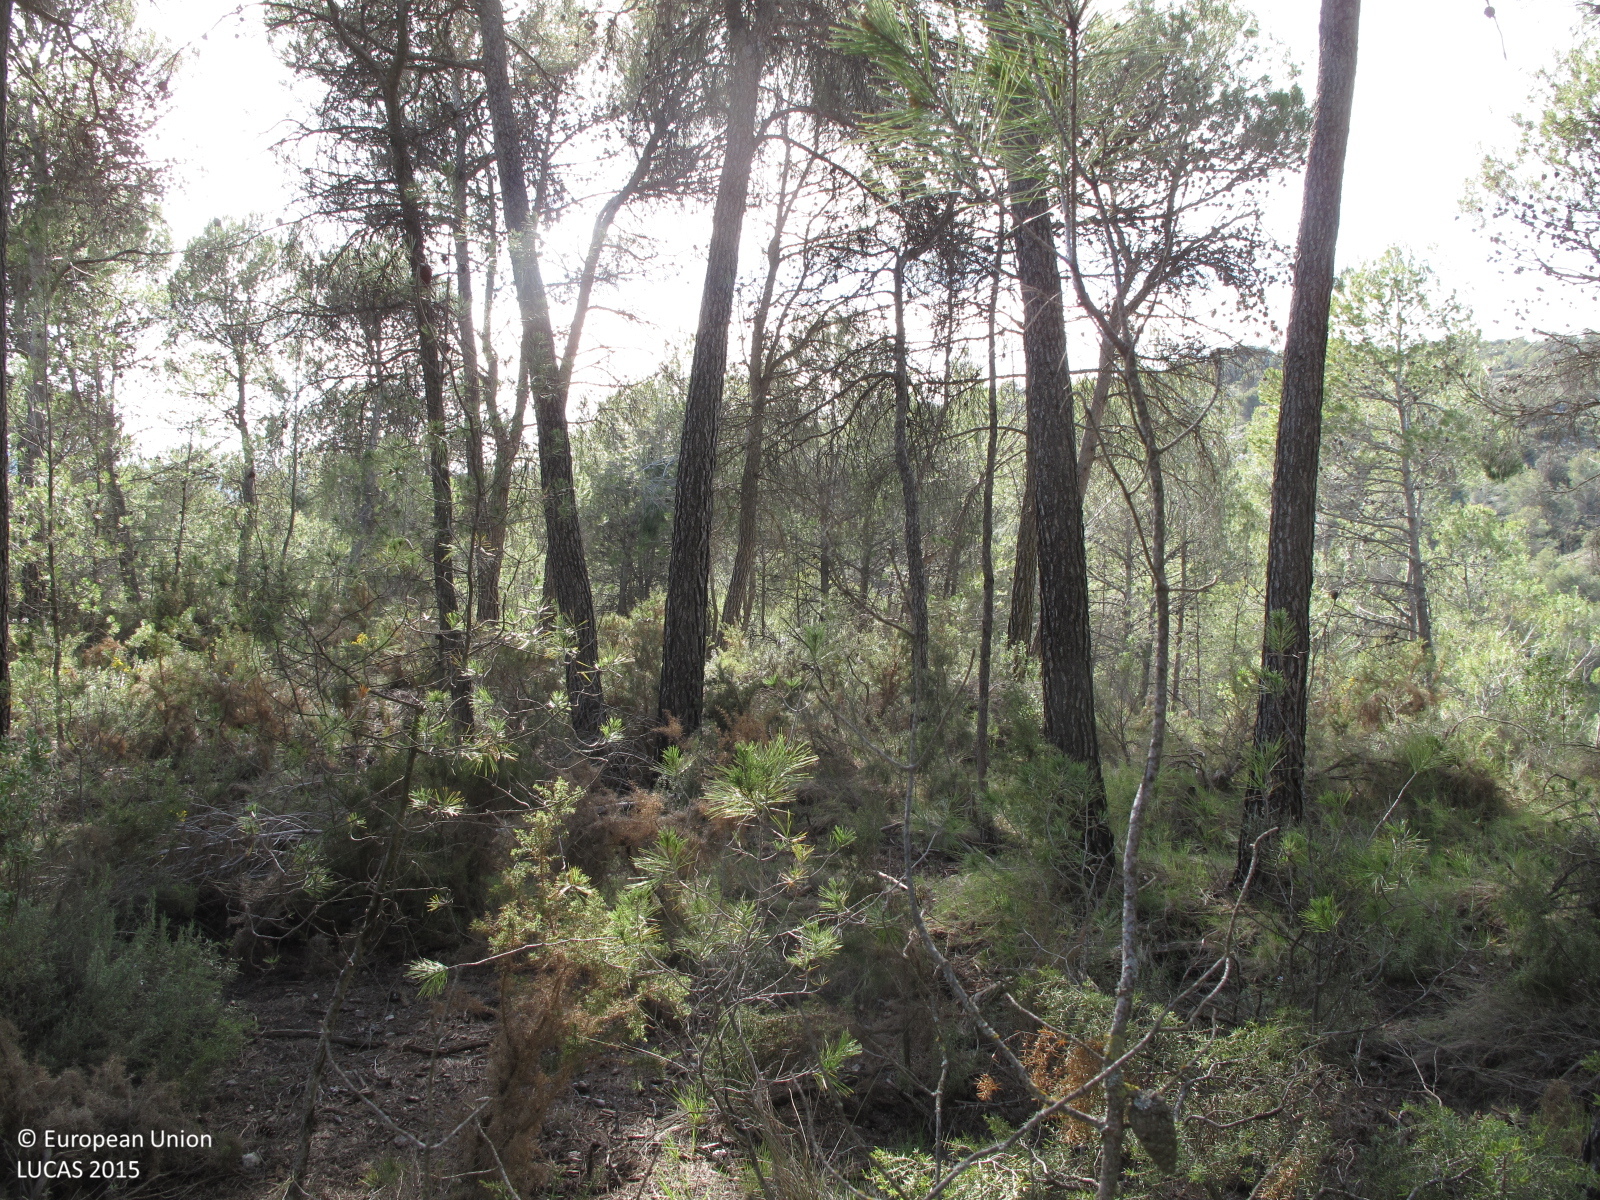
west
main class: Woodland
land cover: Pine dominated coniferous woodland
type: coniferous forest of the mediterranean region
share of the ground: > 75 %
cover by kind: coniferous forest trees 80 %, shrubs 10 %, herbaceous plants 10 %
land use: Semi-natural and natural areas not in use
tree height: > 5 m
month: March
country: ES
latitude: 38.7158
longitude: -0.5129
